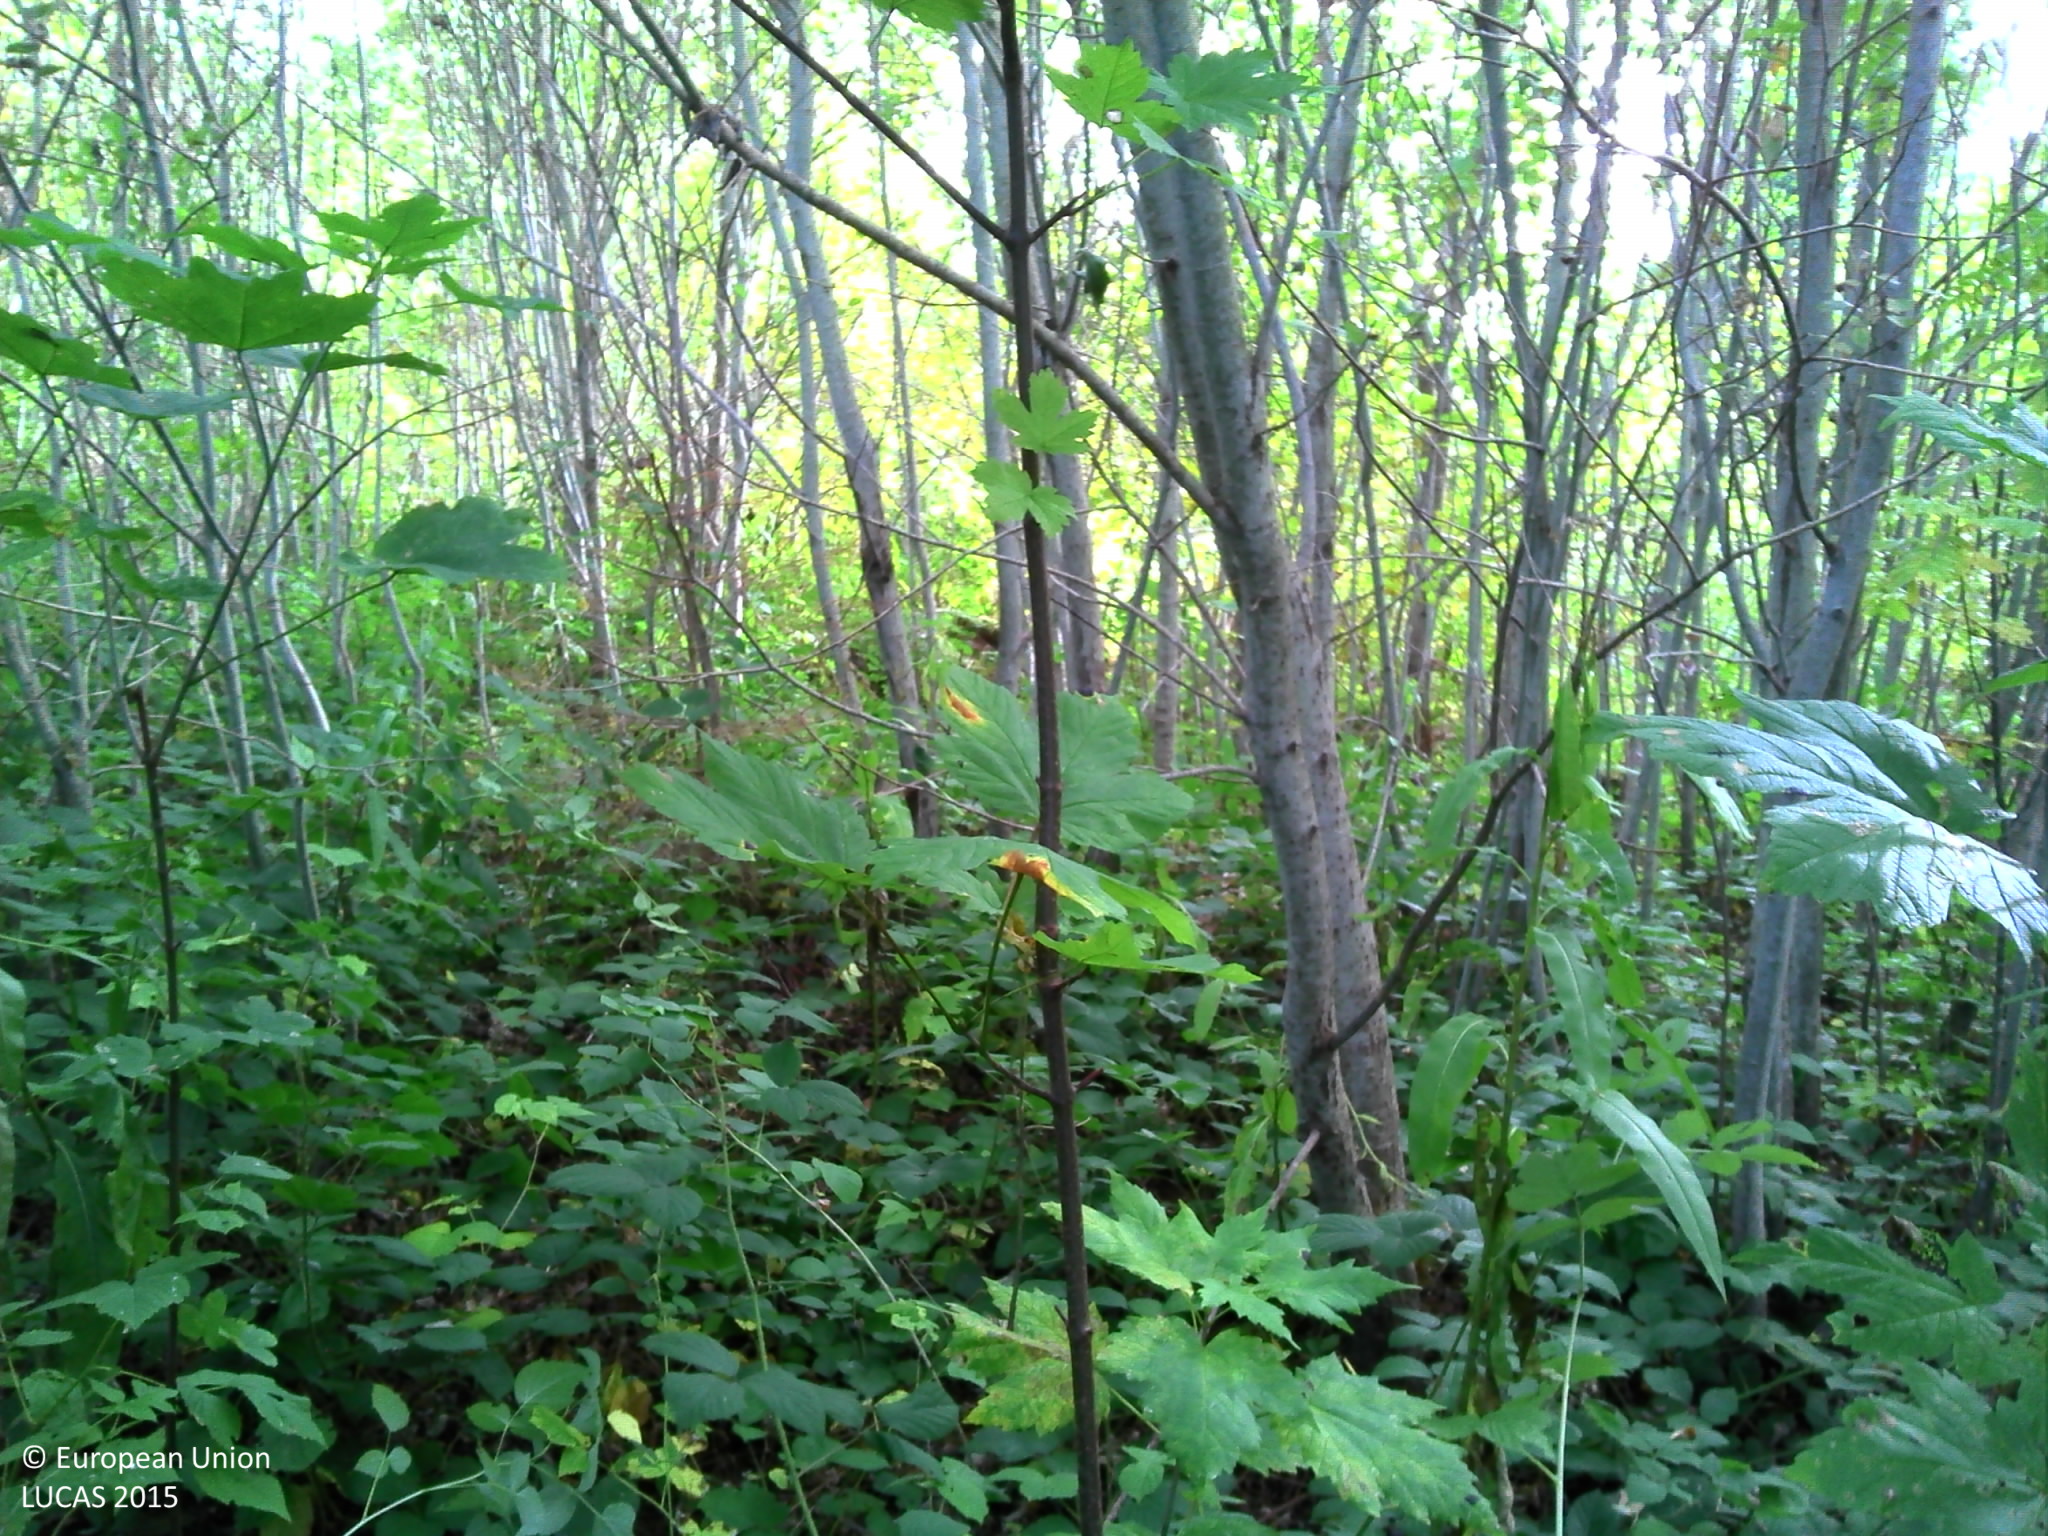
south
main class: Woodland
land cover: Broadleaved woodland
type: mesophytic deciduous forest
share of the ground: 50 - 75 %
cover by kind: broadleaved forest trees 75 %, shrubs 25 %
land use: Forestry
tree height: > 5 m
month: October
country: FR
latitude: 47.0283
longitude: 6.3574
